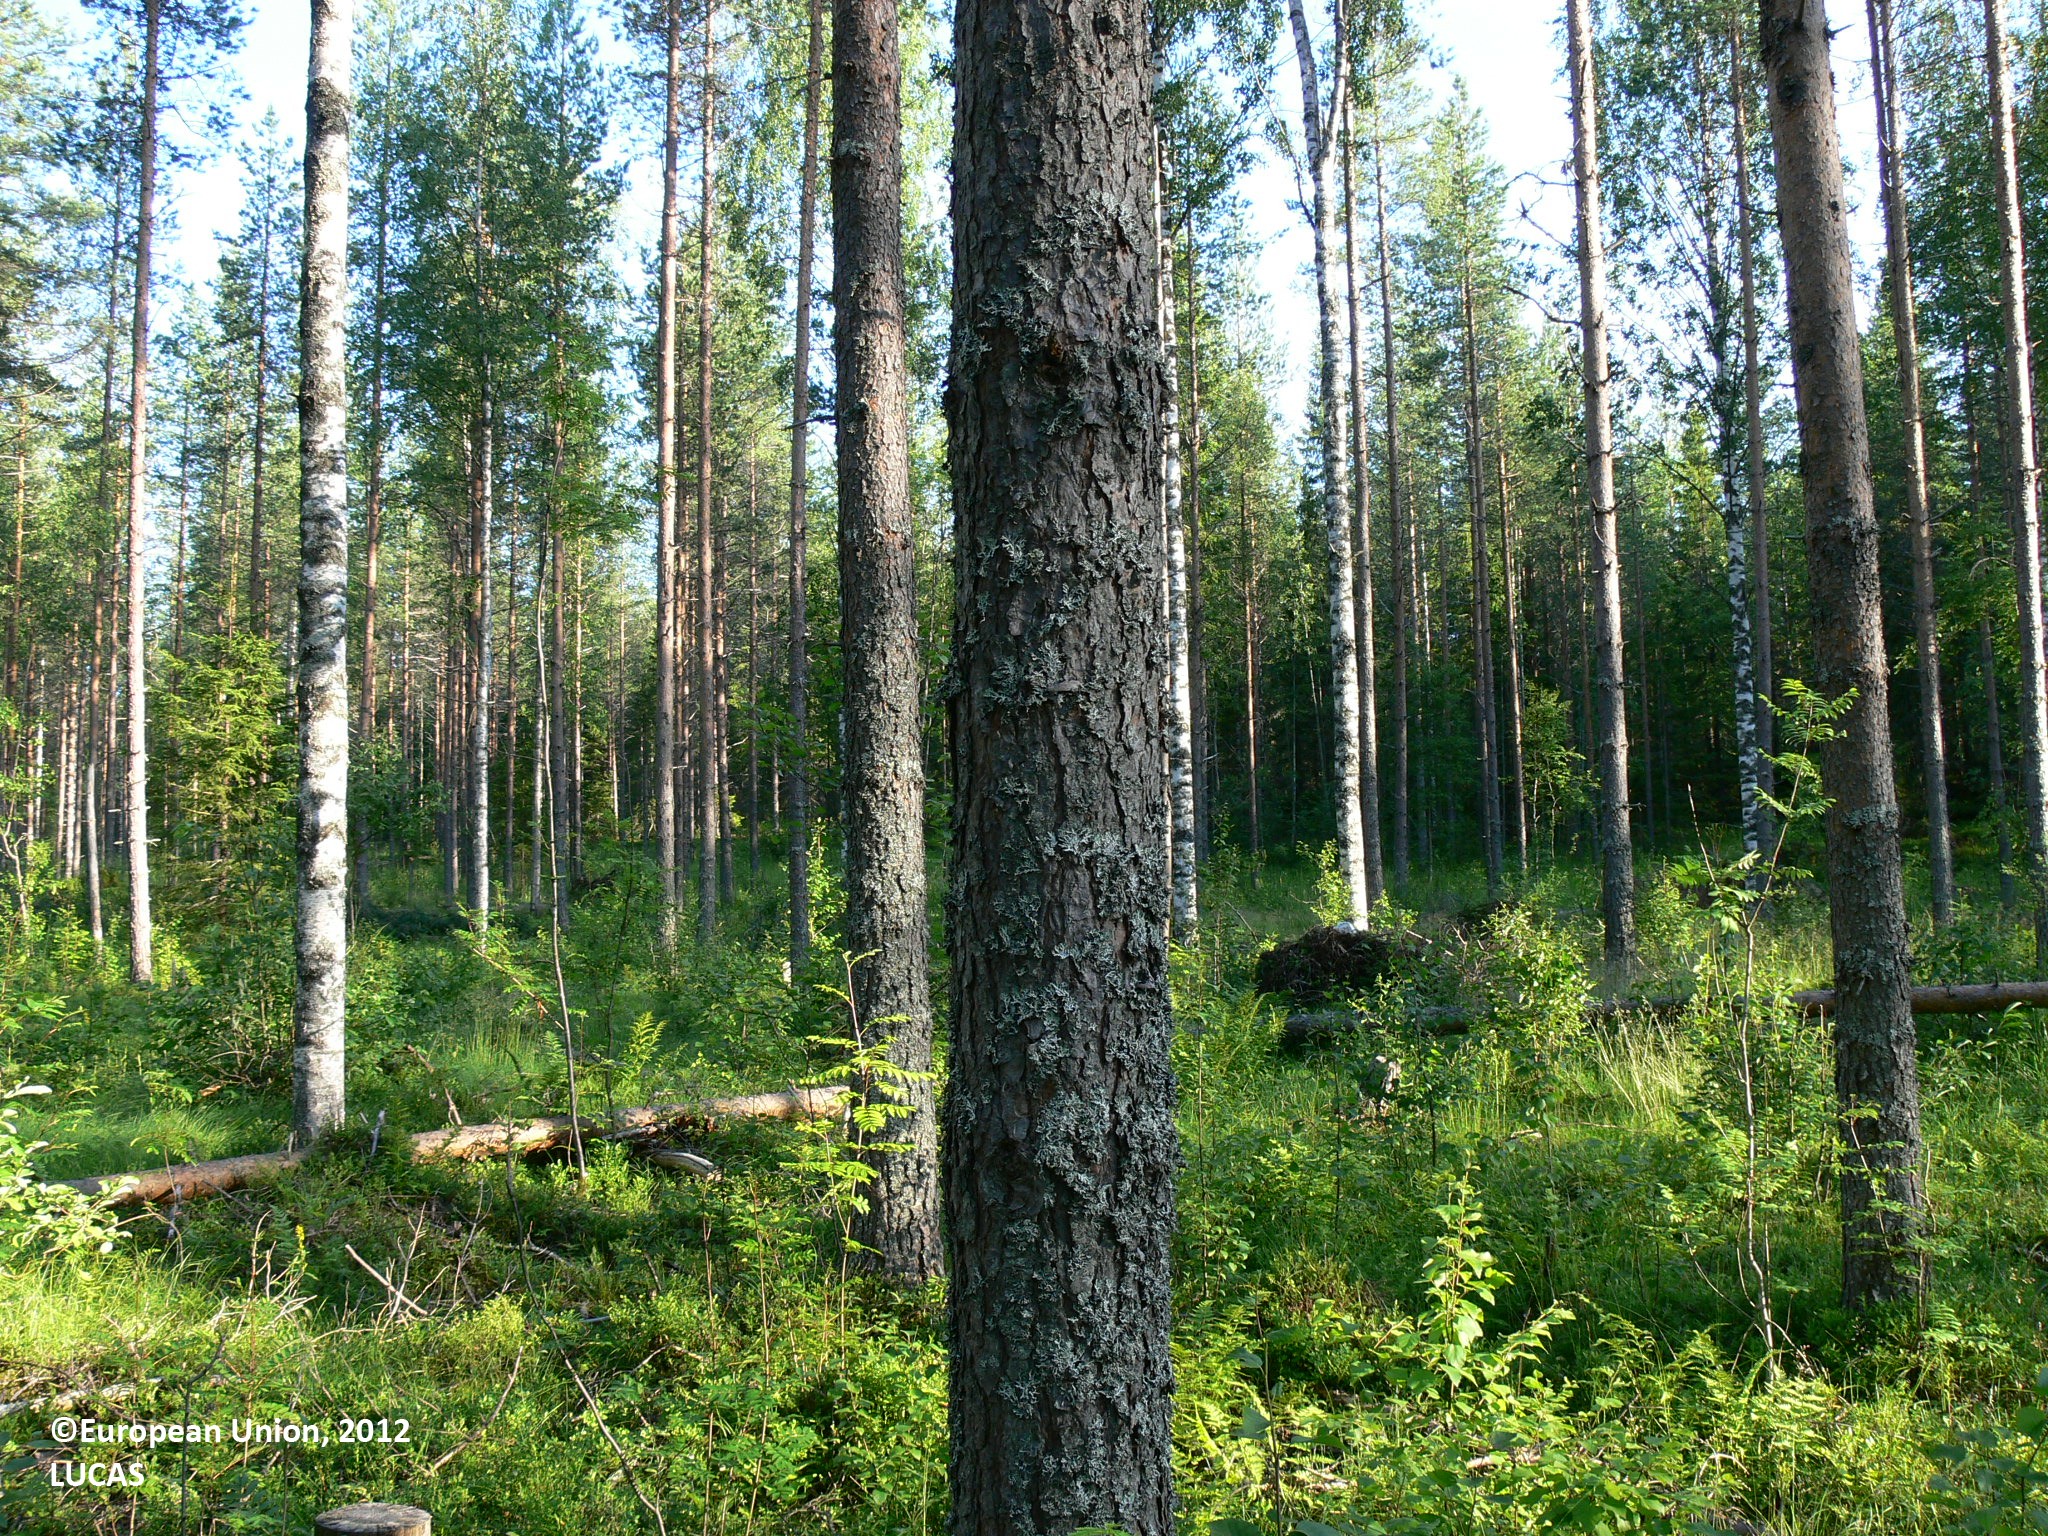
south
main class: Woodland
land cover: Pine dominated mixed woodland
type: boreal forest
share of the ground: > 75 %
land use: Forestry
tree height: > 5 m
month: July
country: FI
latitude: 63.2985
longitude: 30.8965
